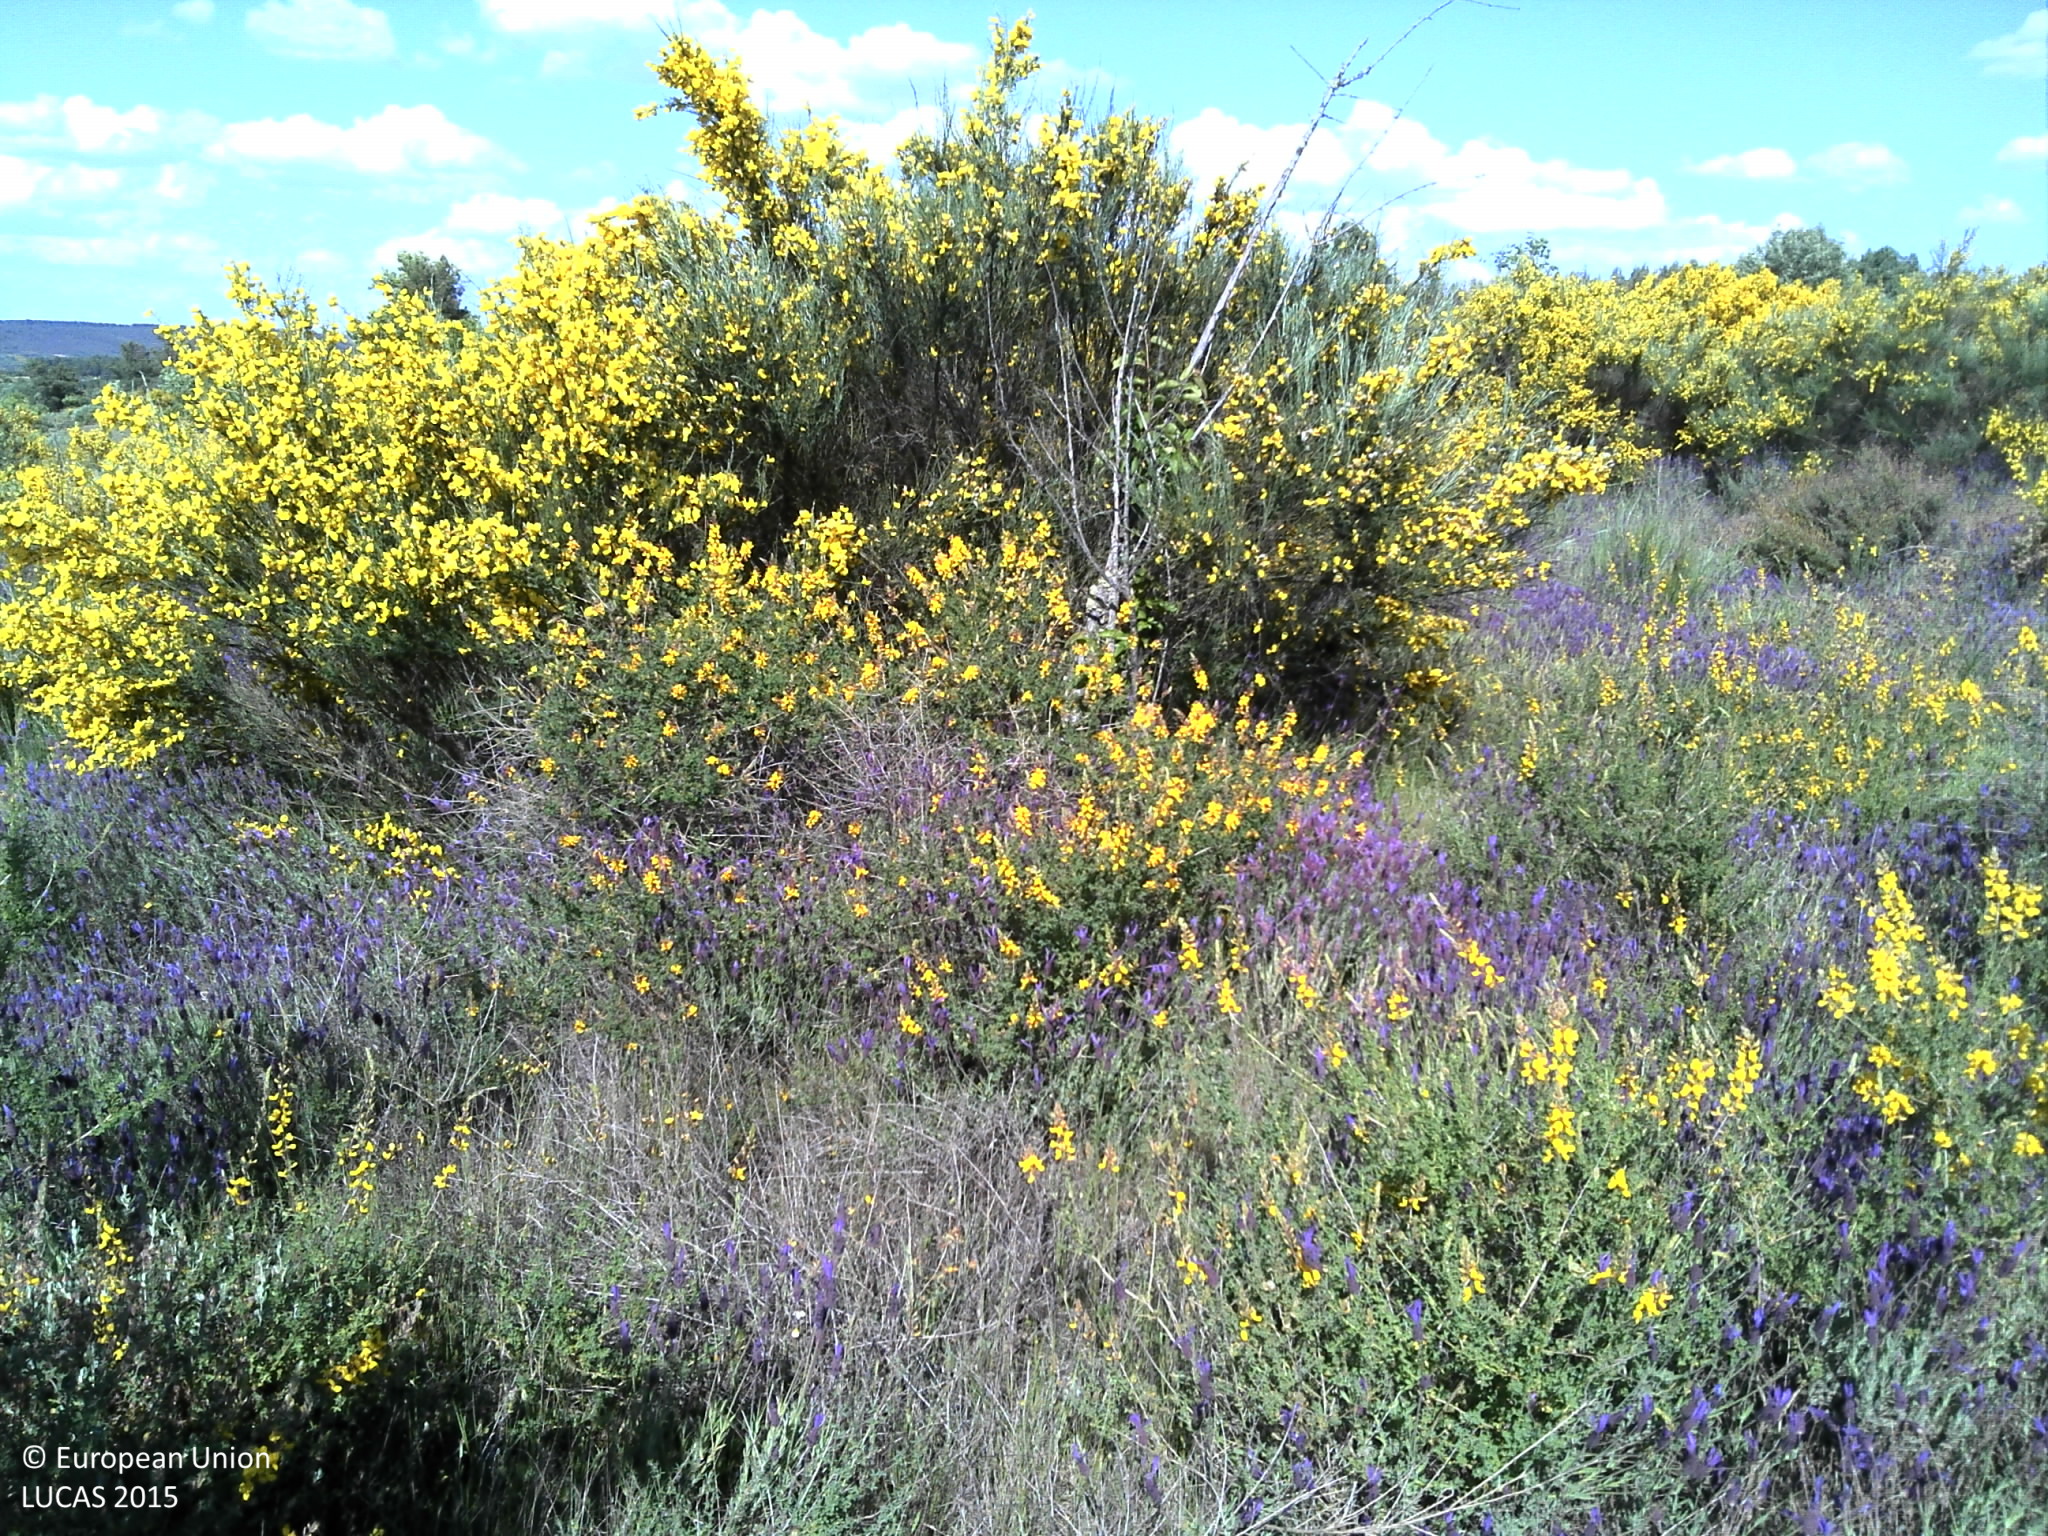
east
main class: Shrubland
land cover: Shrubland with sparse tree cover
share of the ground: > 75 %
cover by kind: shrubs 90 %, broadleaved forest trees 5 %, herbaceous plants 5 %
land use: Abandoned areas
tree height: < 5 m
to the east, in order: Shrubland with sparse tree cover; Nuts trees; Shrubland with sparse tree cover
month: May
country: PT
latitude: 41.6427
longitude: -6.3698
